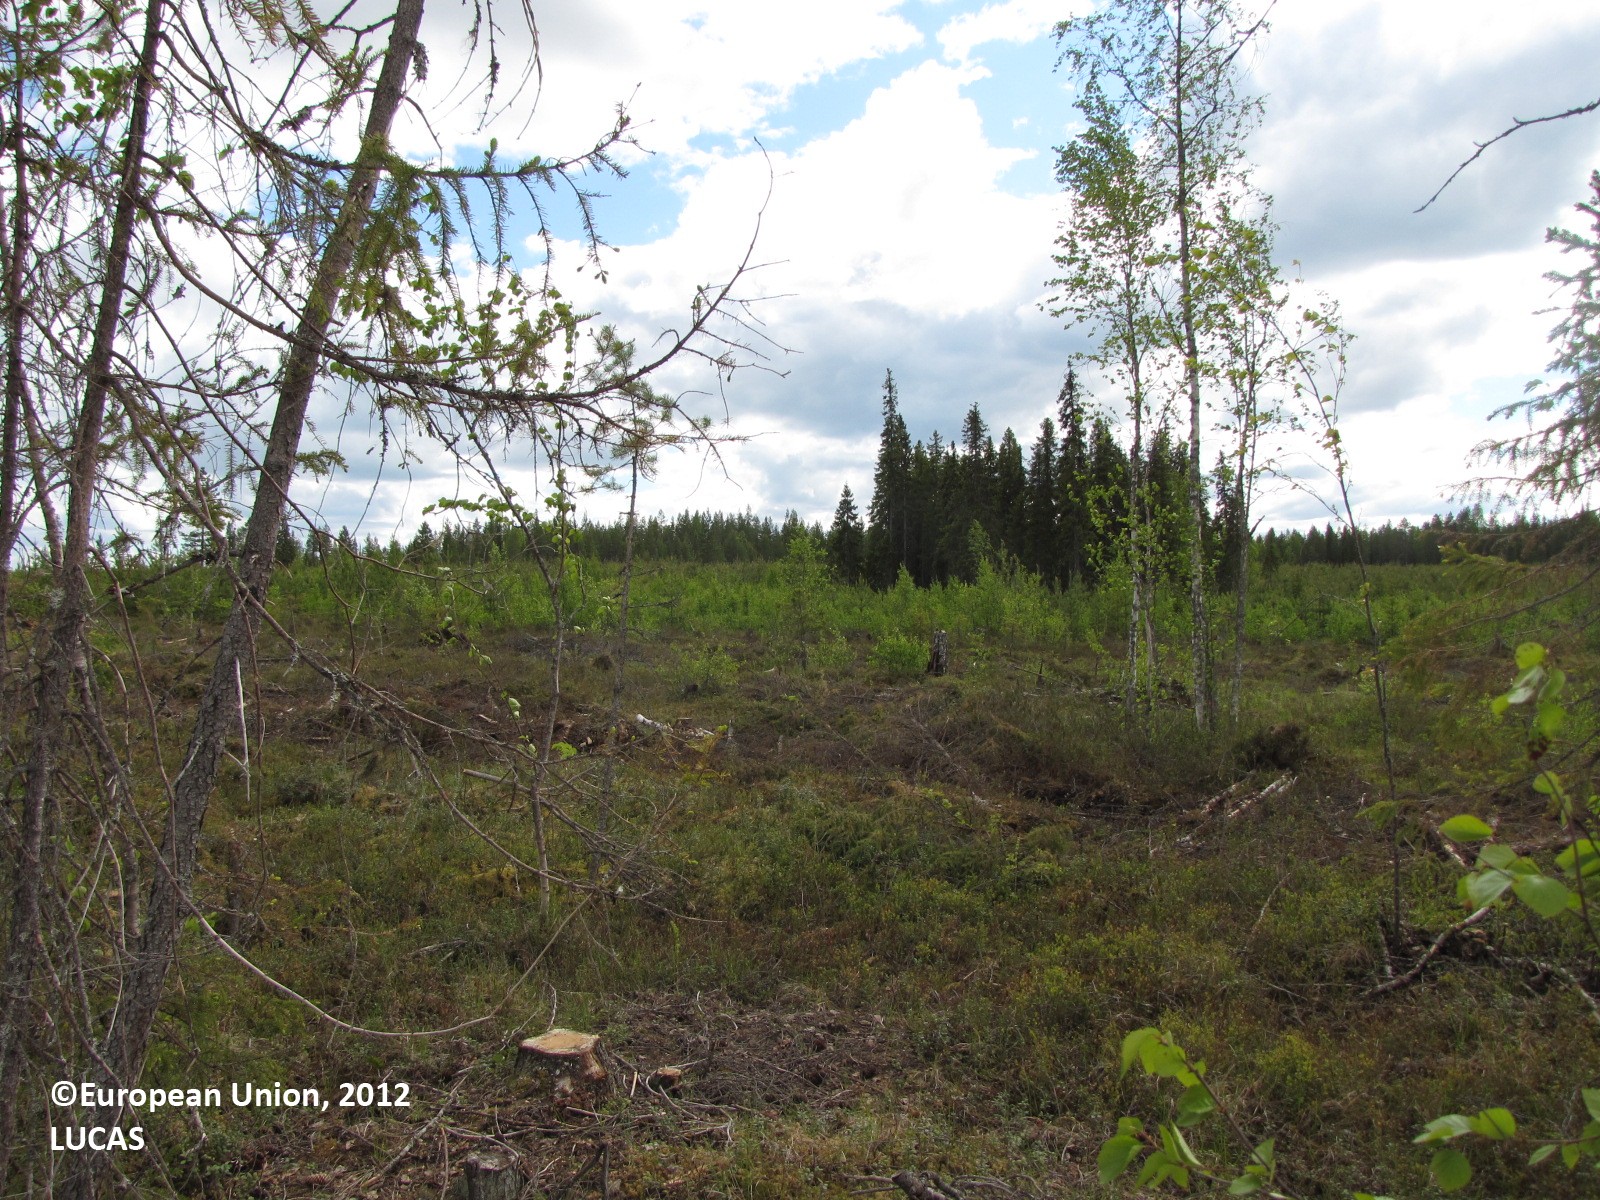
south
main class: Woodland
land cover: Other mixed woodland
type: boreal forest
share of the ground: 10 - 25 %
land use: Forestry
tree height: > 5 m
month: June
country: FI
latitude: 66.1069
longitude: 25.1294
